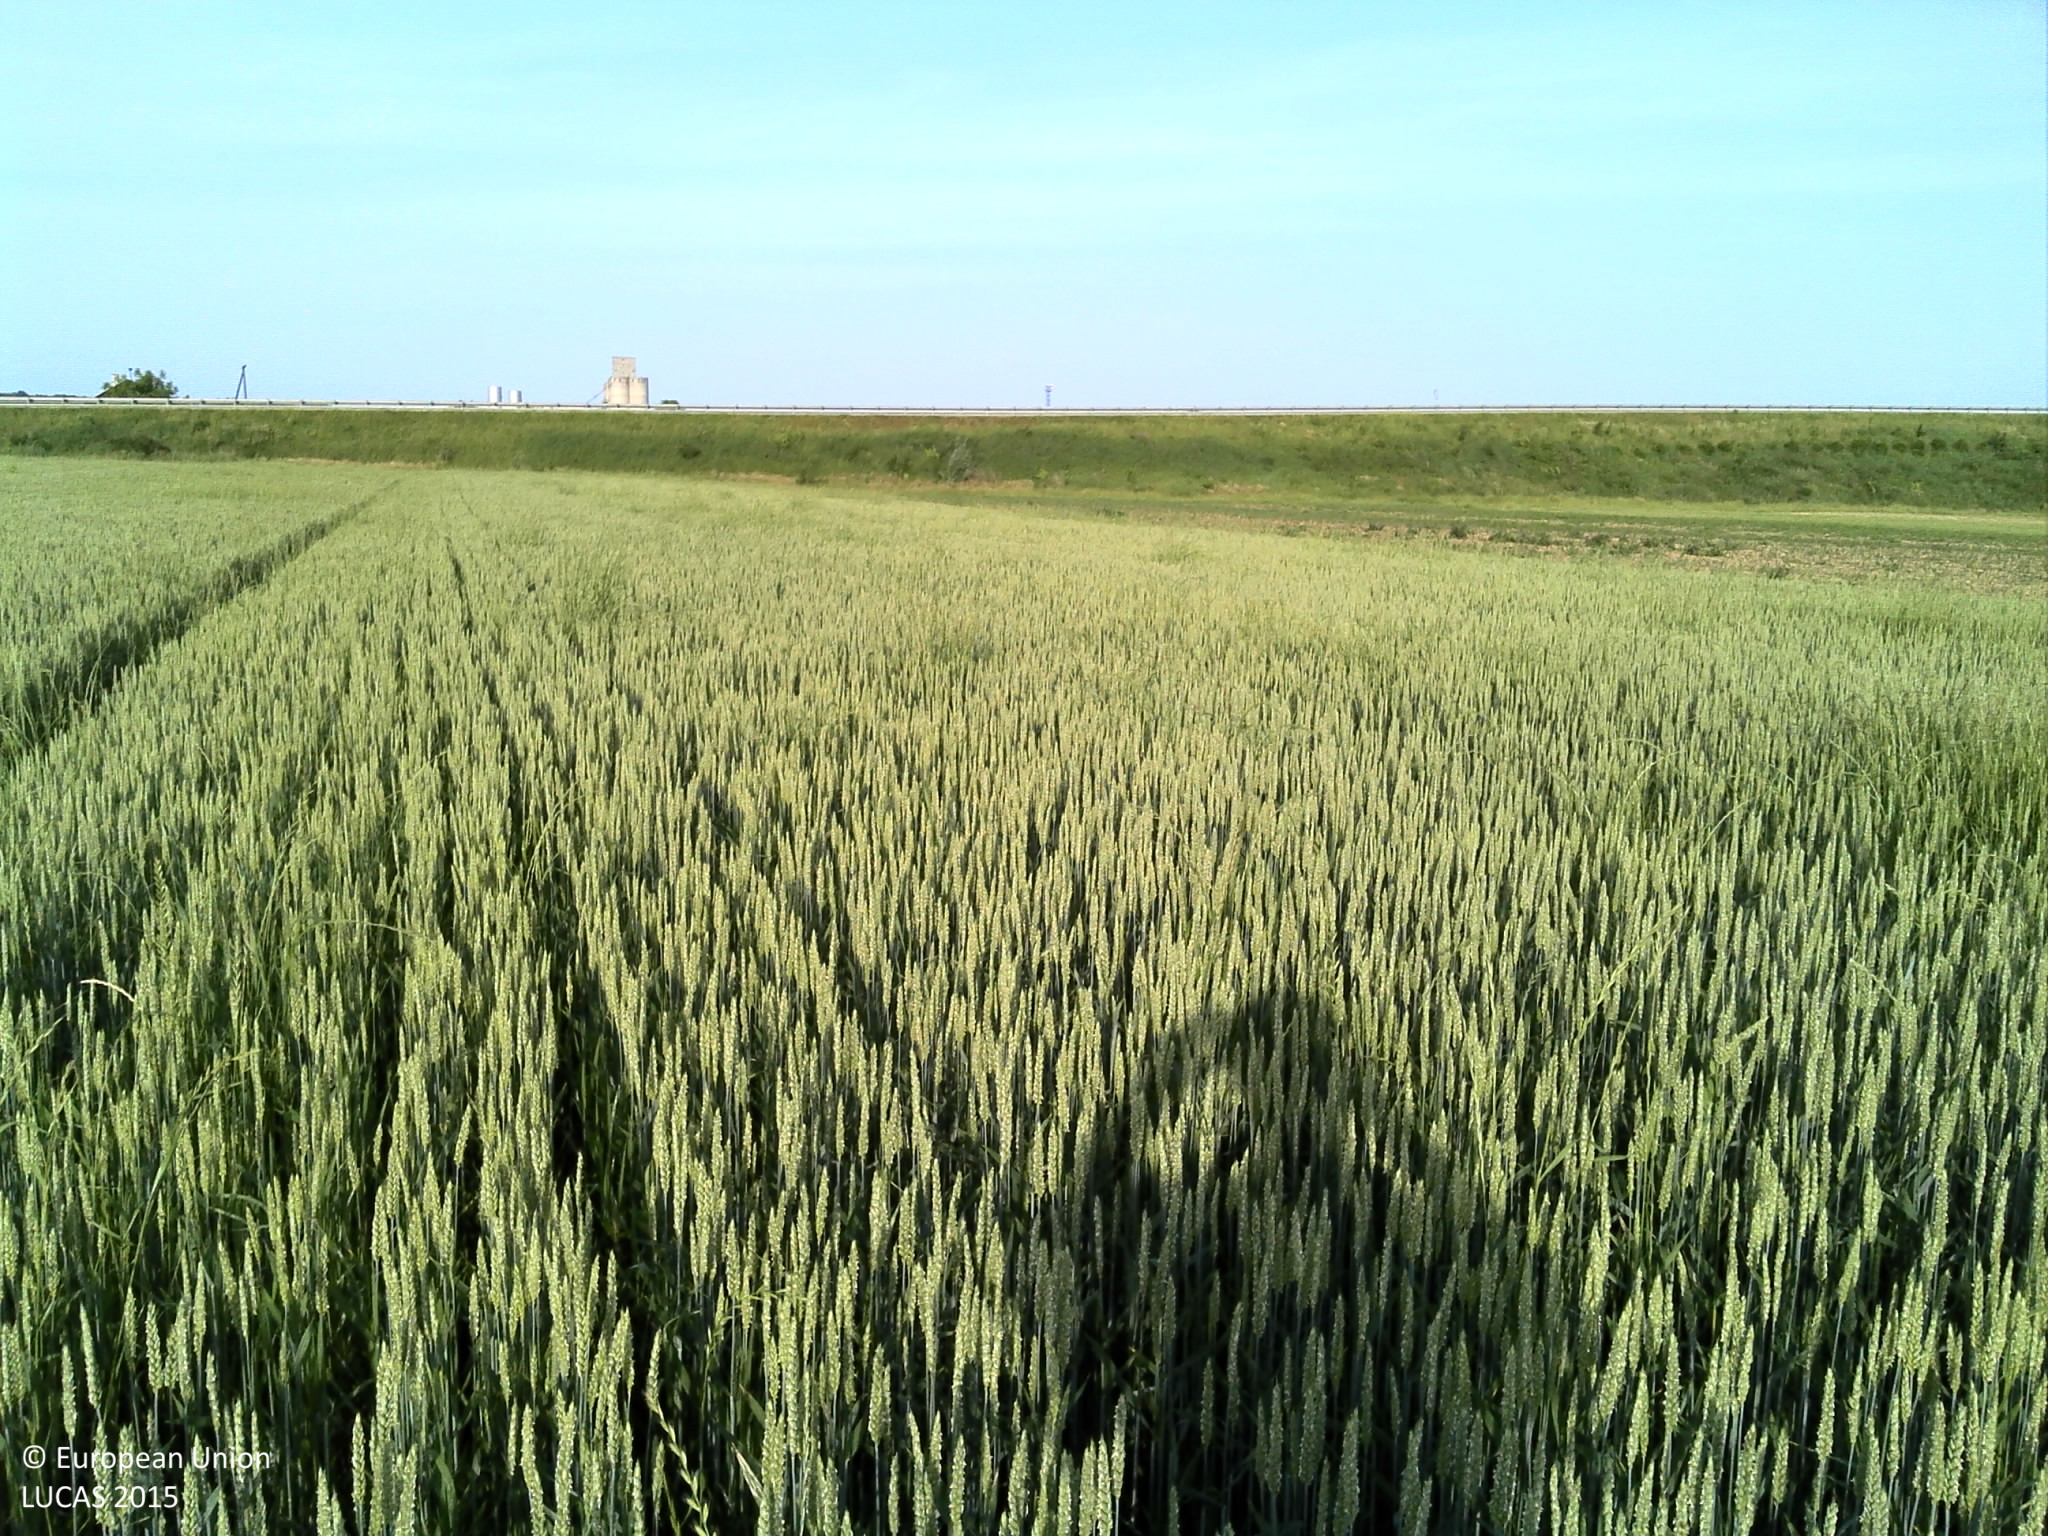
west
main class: Cropland
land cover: Common wheat
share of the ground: > 75 %
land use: Agriculture (excluding fallow land and kitchen gardens)
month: May
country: HR
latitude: 45.4983
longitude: 18.1306
